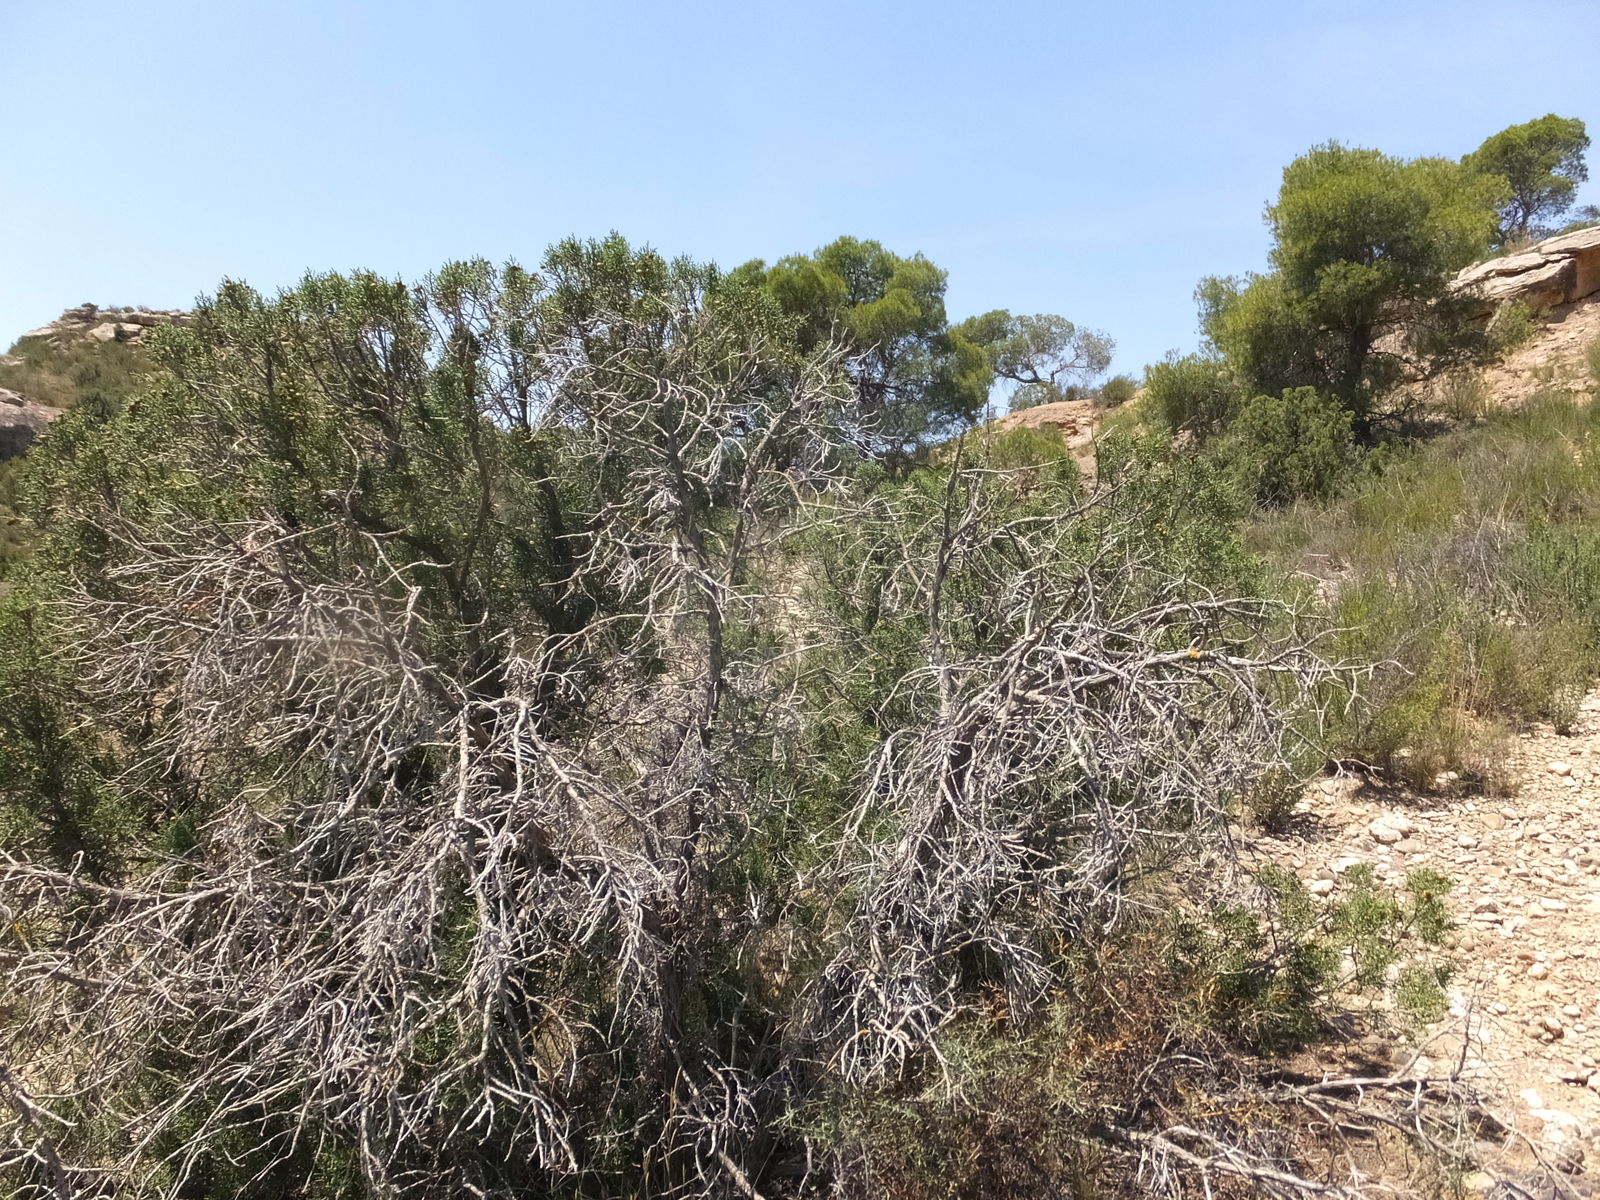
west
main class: Shrubland
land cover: Shrubland with sparse tree cover
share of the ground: > 75 %
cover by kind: shrubs 50 %, herbaceous plants 30 %, unconsolidated bare surface 10 %, coniferous forest trees 5 %, consolidated bare surface 5 %
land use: Semi-natural and natural areas not in use
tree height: < 5 m
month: June
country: ES
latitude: 41.3031
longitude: -0.1777
